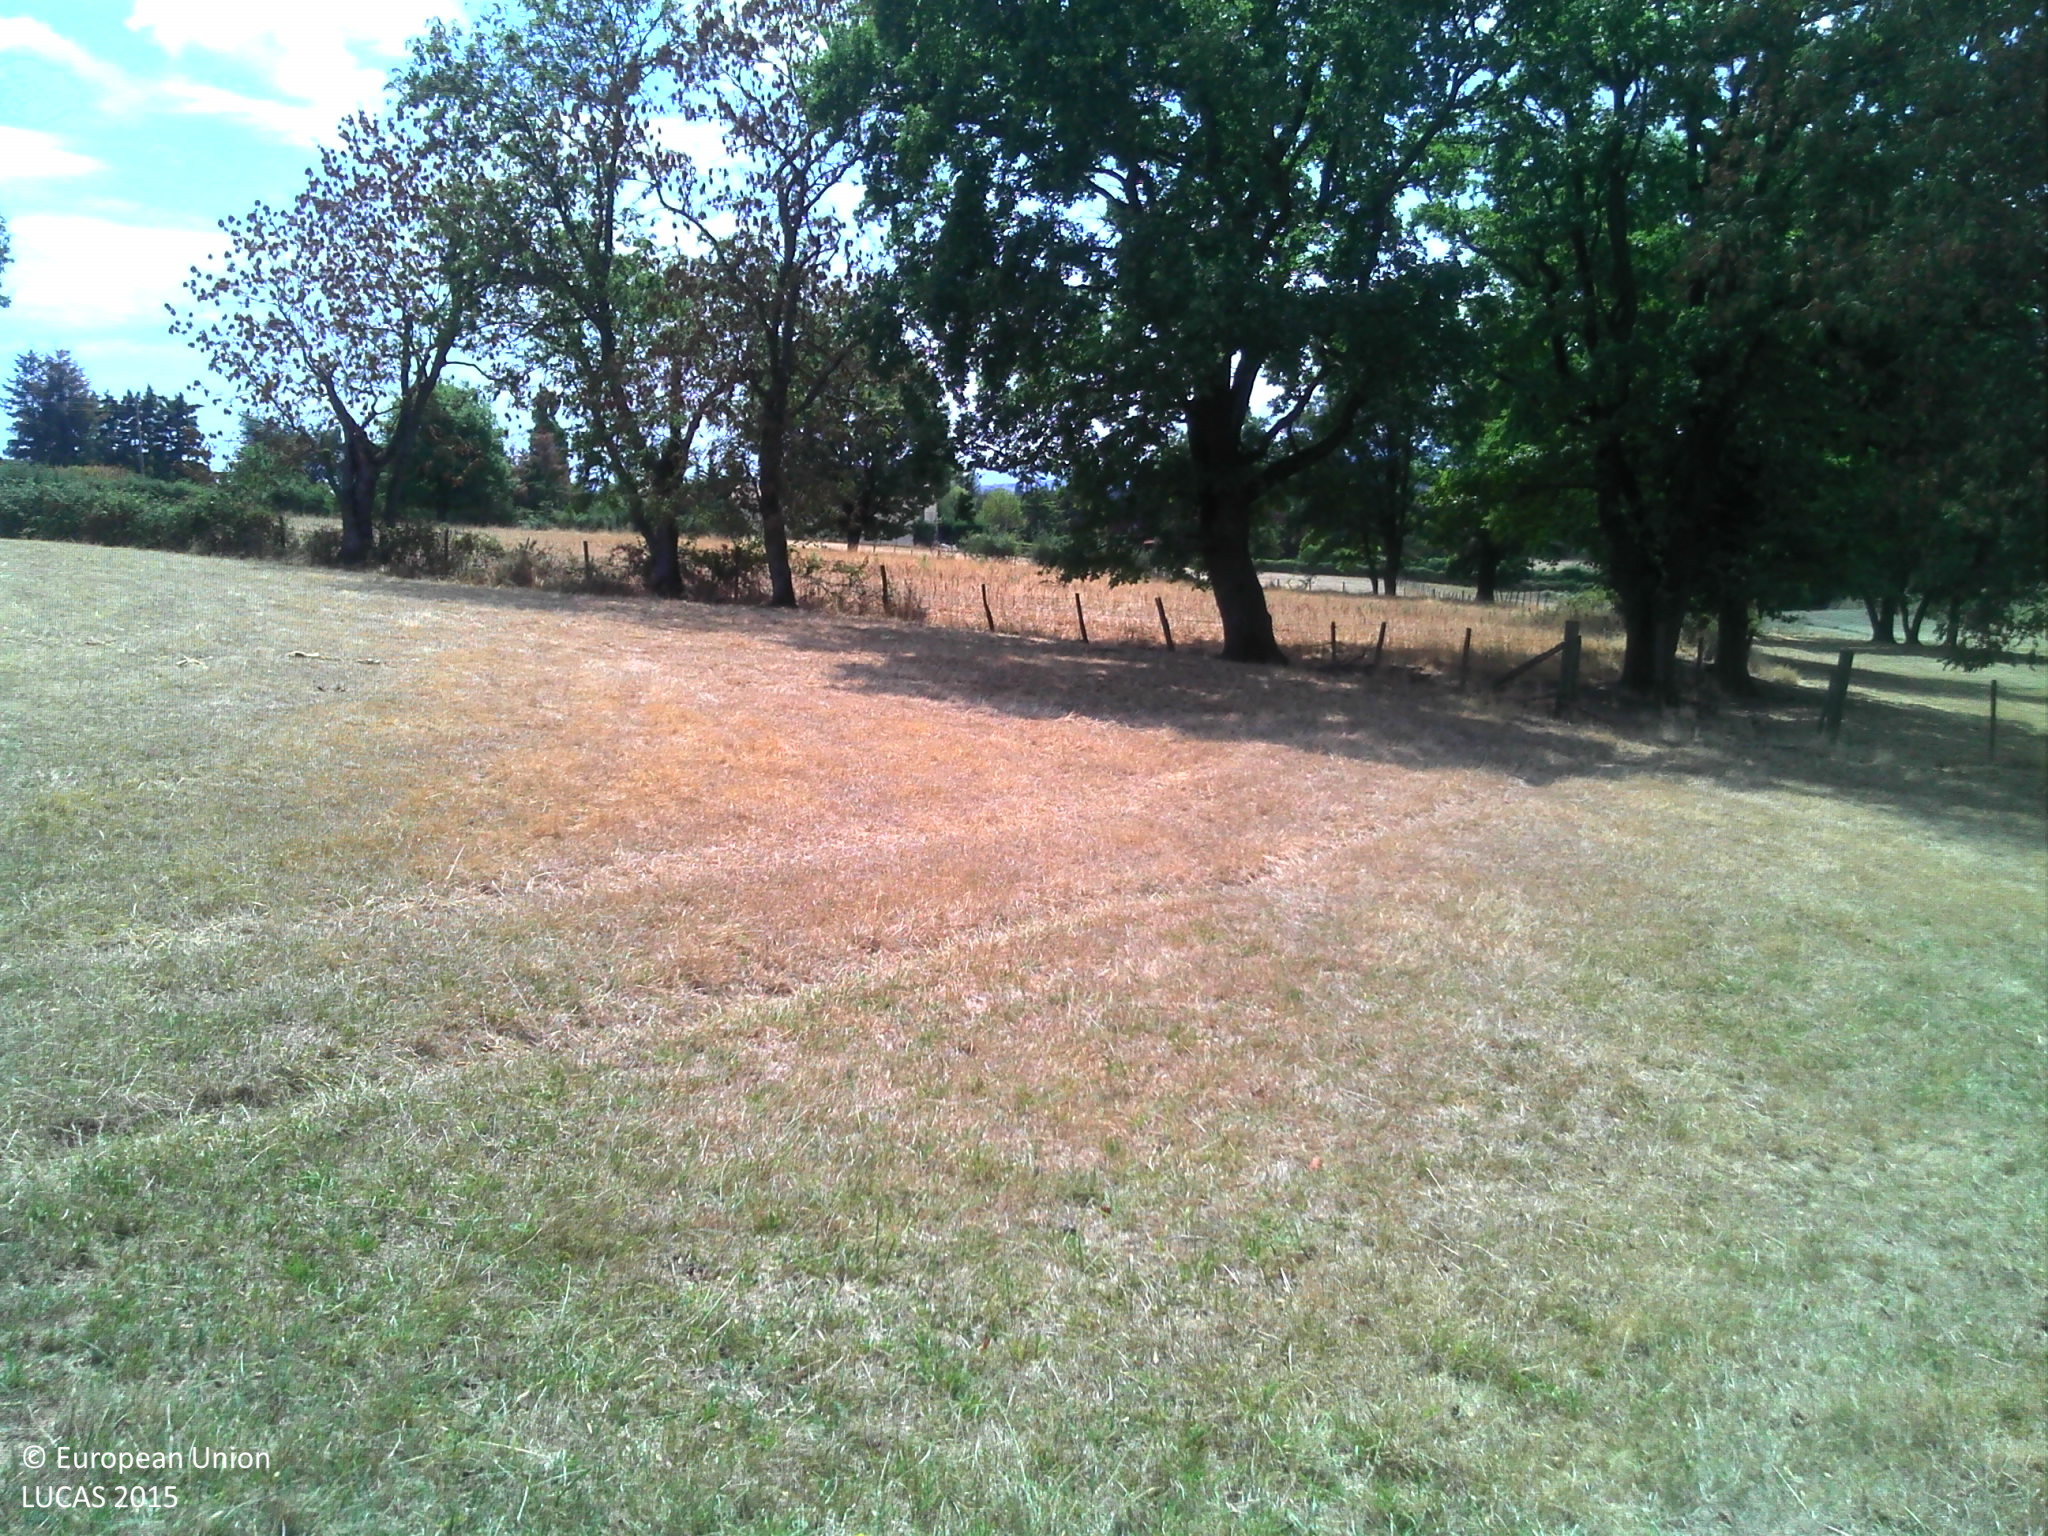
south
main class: Grassland
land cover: Grassland without tree/shrub cover
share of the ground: > 75 %
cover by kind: herbaceous plants 100 %
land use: Agriculture (excluding fallow land and kitchen gardens)
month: August
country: FR
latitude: 45.7682
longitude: 4.6927
